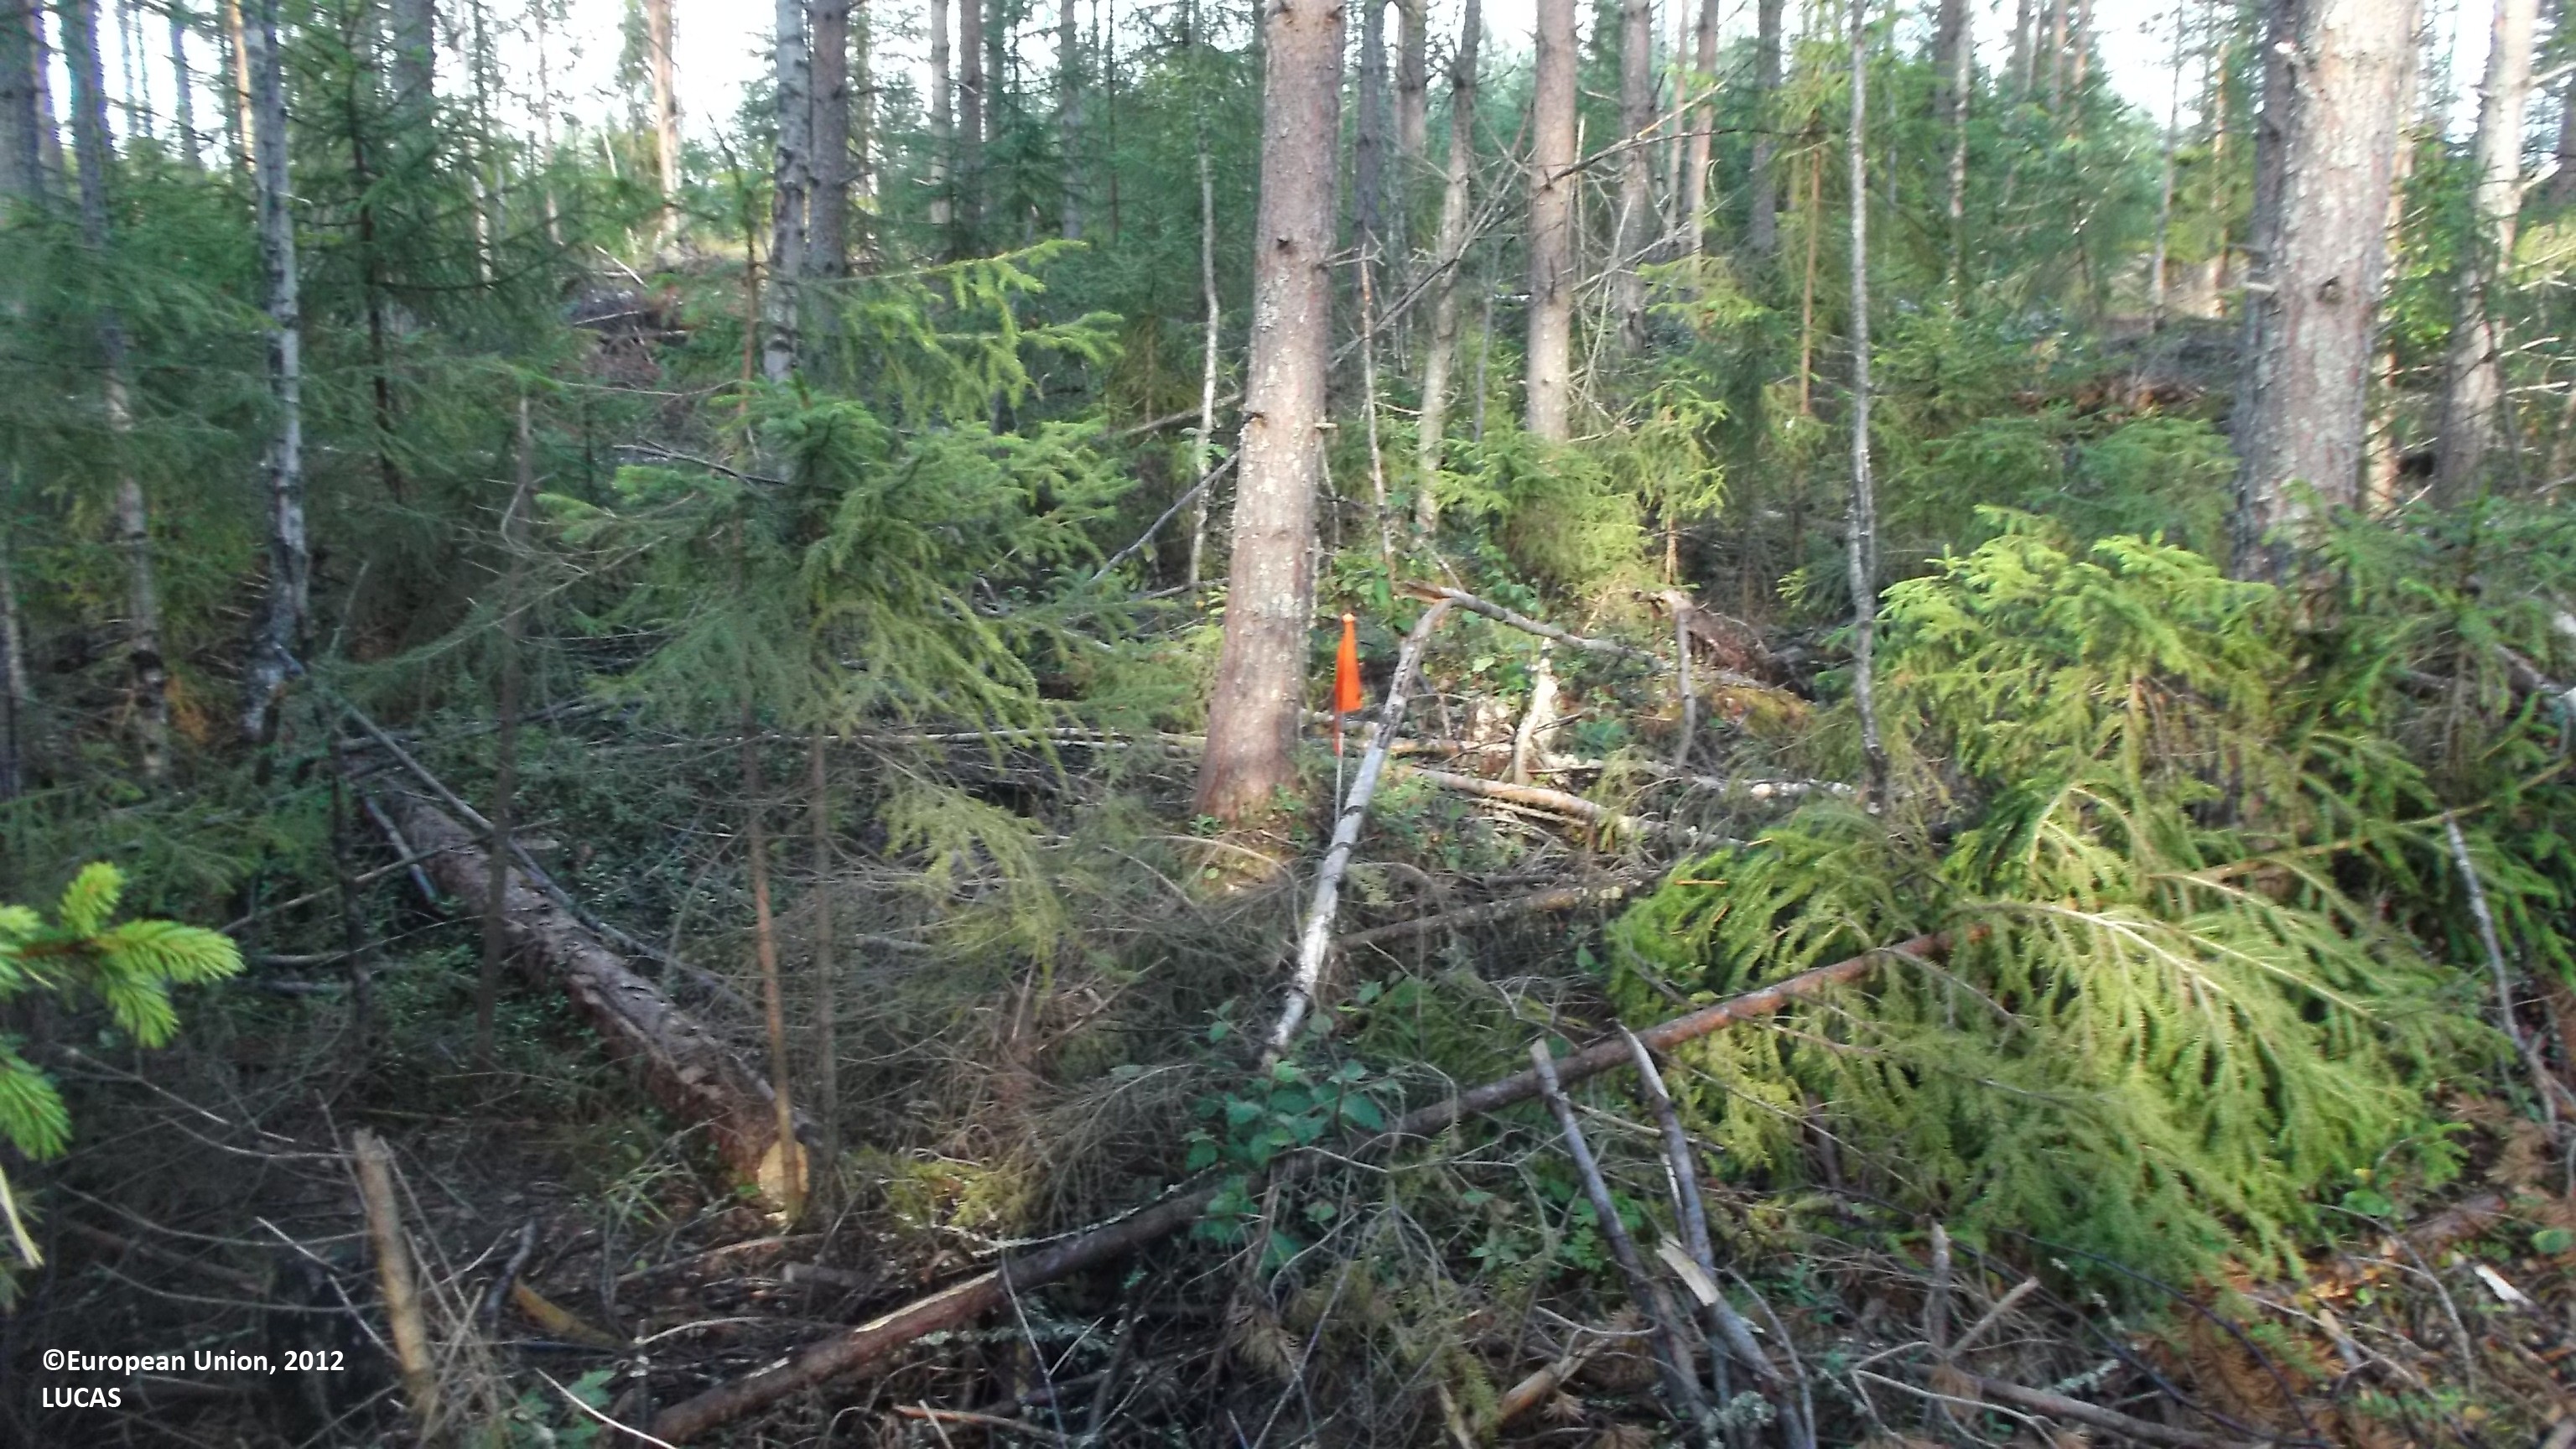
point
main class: Woodland
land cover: Pine dominated mixed woodland
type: boreal forest
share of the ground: 25 - 50 %
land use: Forestry
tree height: > 5 m
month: August
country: FI
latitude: 63.9246
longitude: 23.3296
